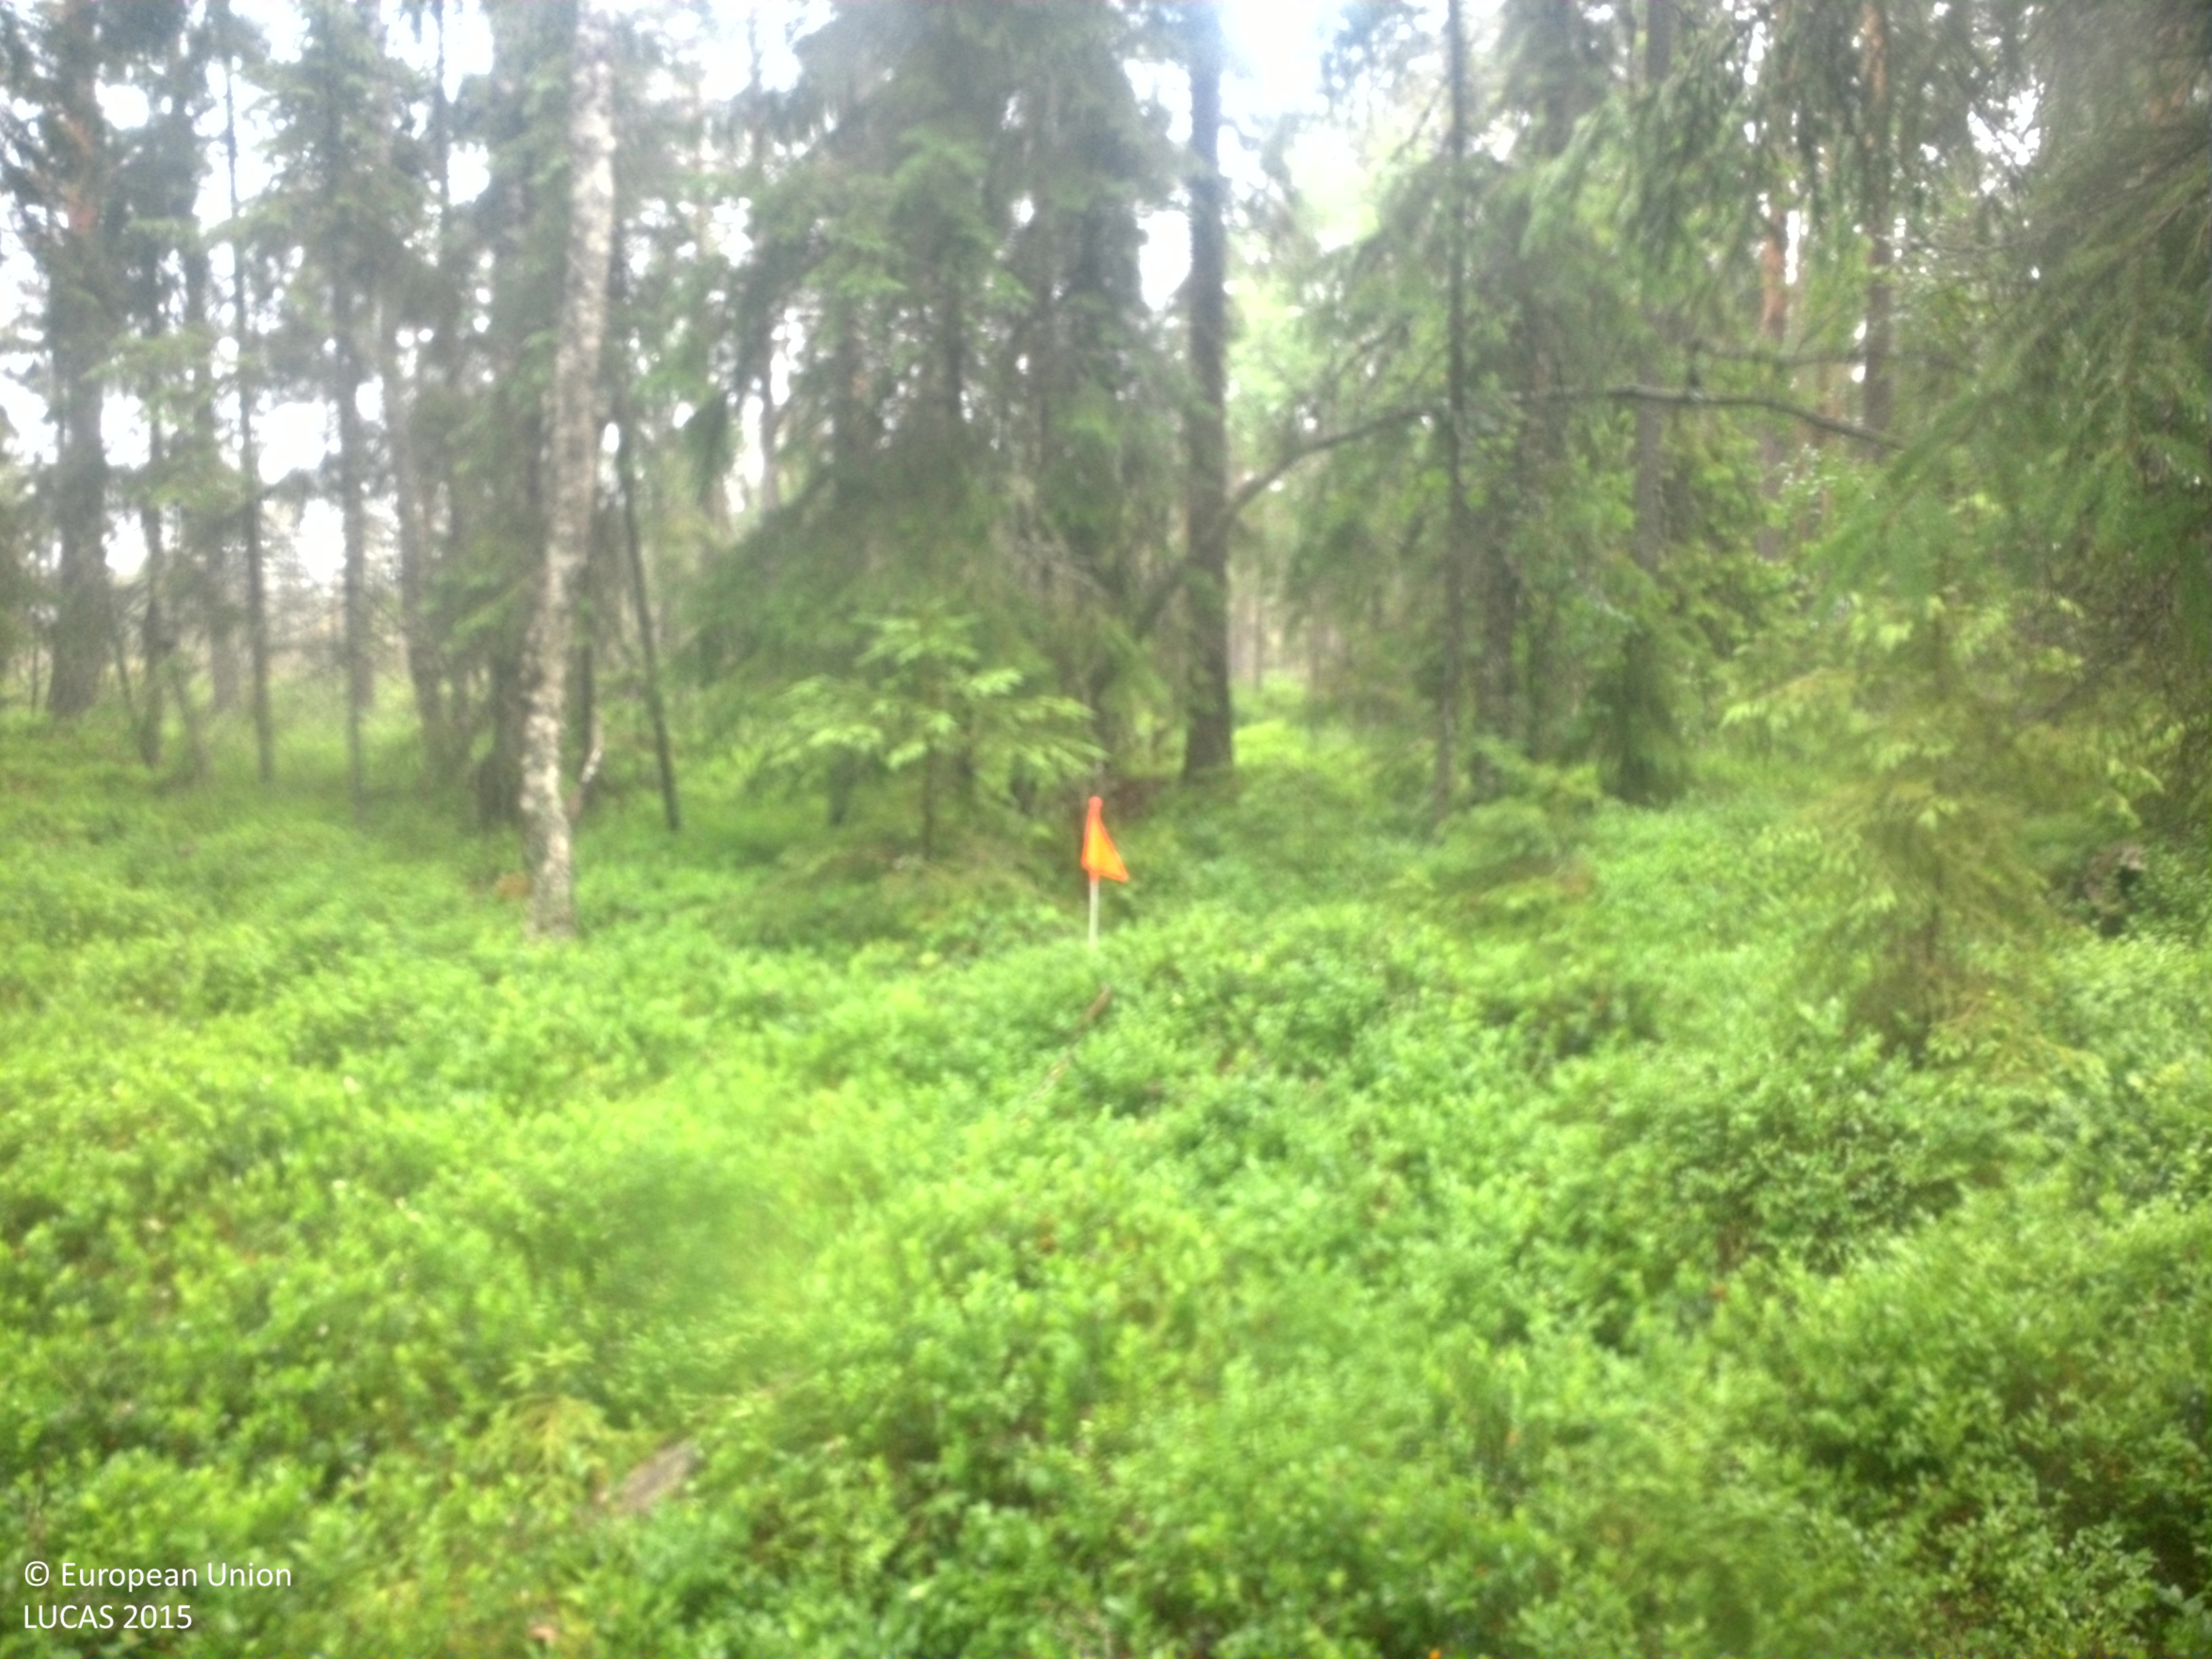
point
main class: Woodland
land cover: Other mixed woodland
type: boreal forest
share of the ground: 50 - 75 %
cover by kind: shrubs 40 %, coniferous forest trees 30 %, broadleaved forest trees 20 %, herbaceous plants 10 %
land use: Forestry
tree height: > 5 m
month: July
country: SE
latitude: 59.3814
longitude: 14.6911
